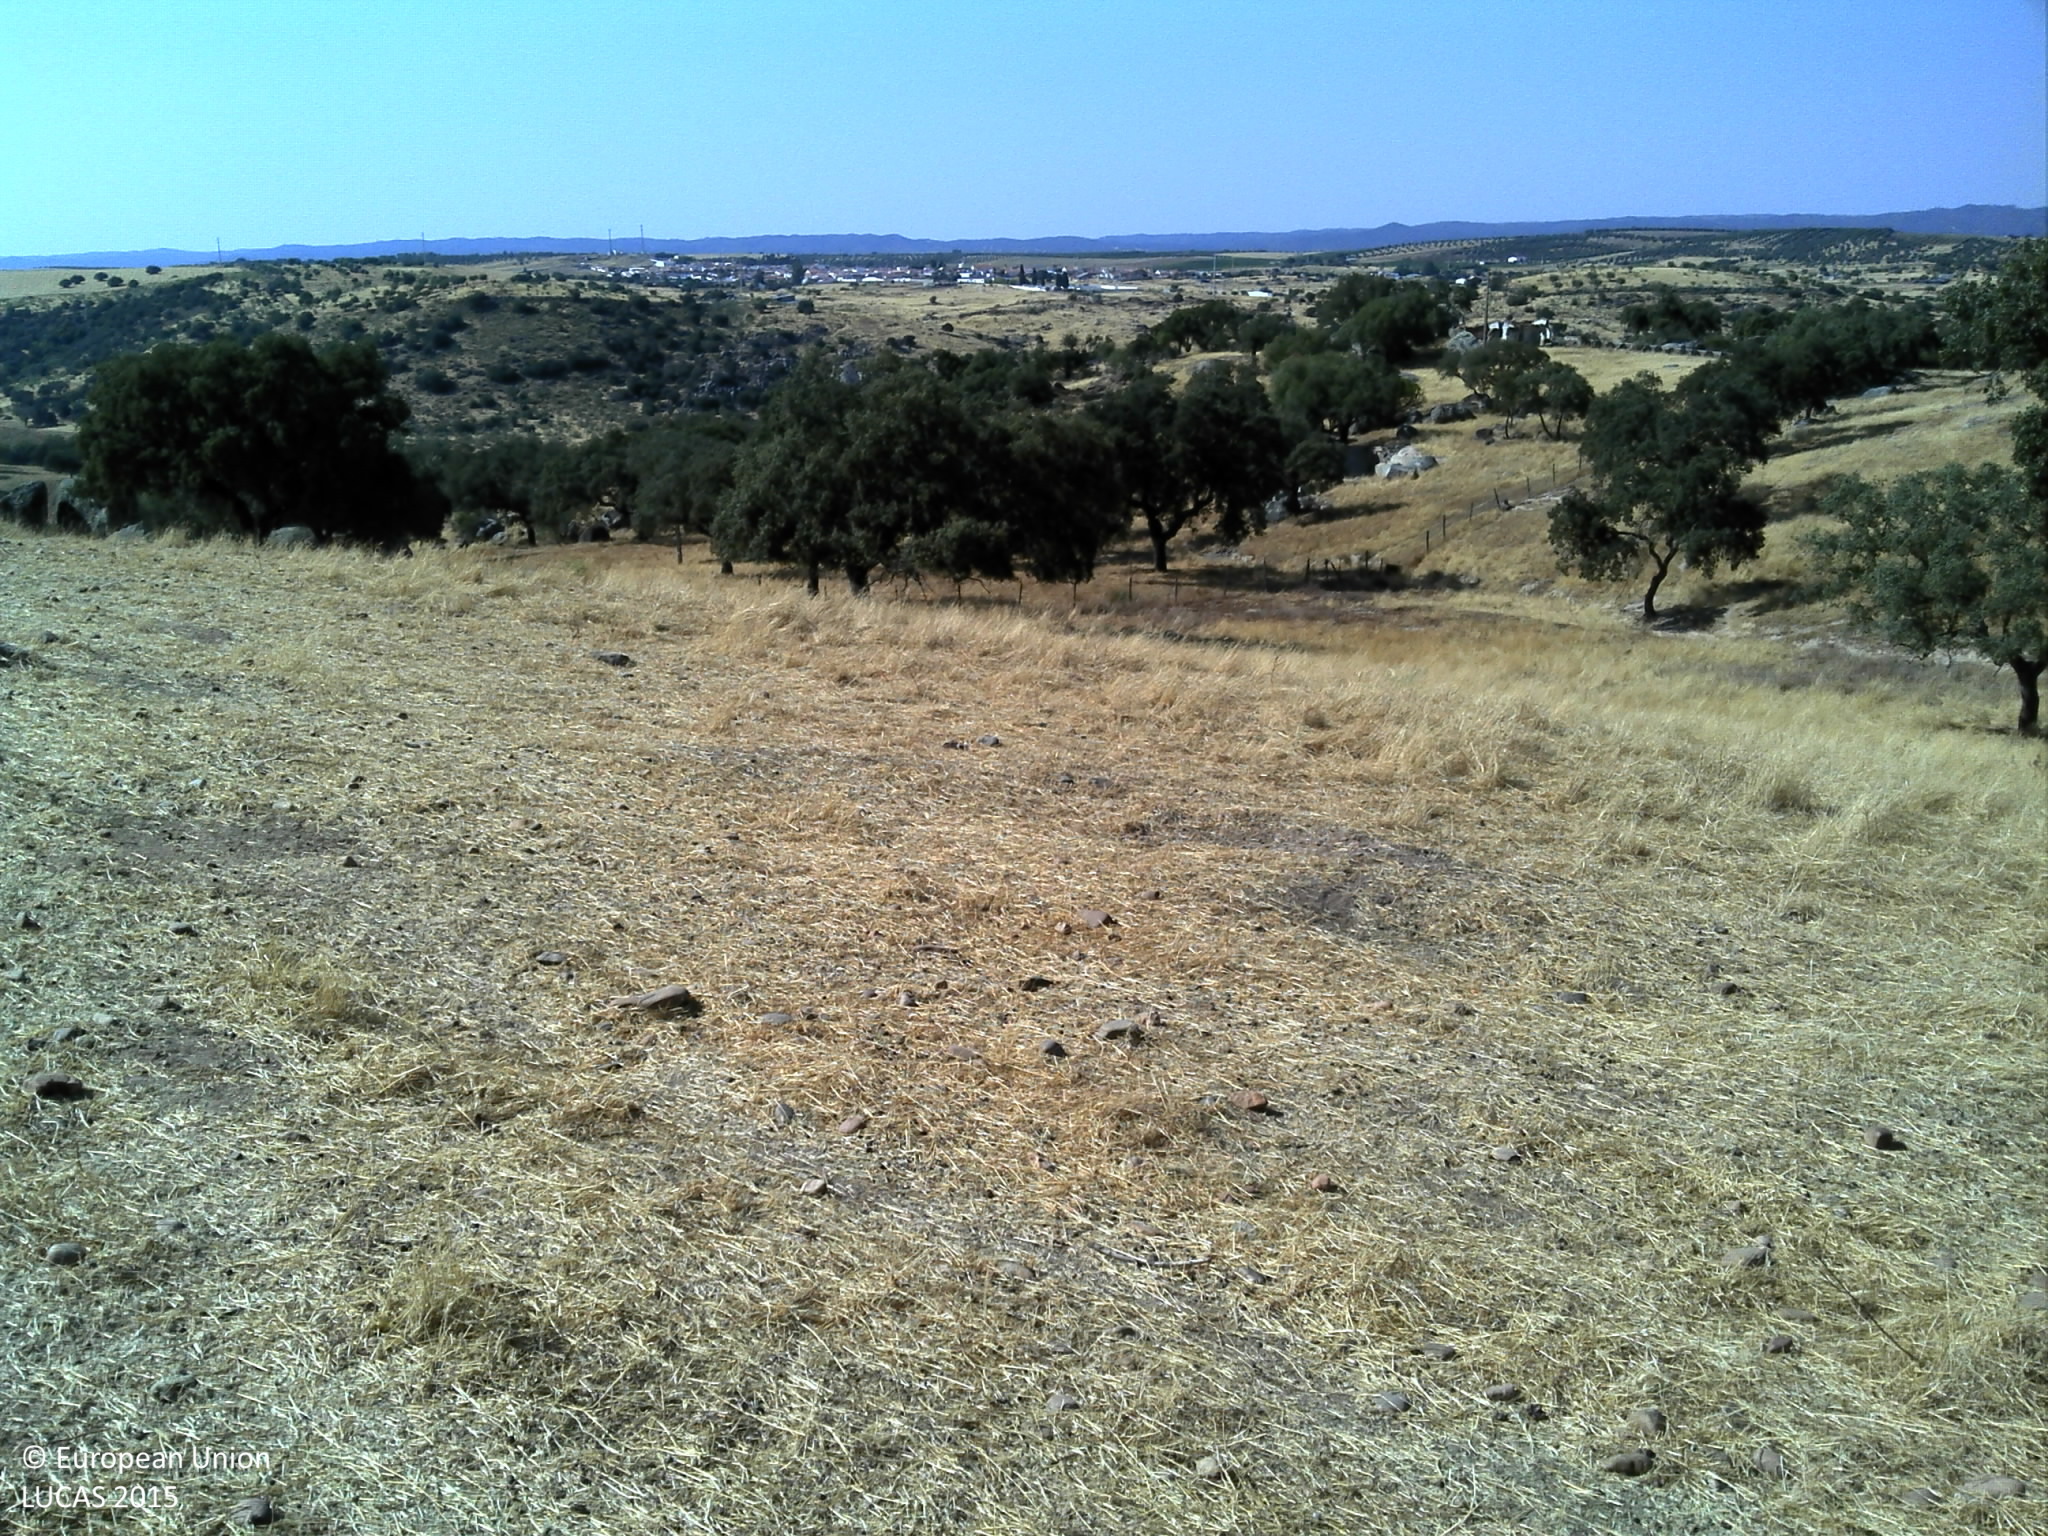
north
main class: Grassland
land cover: Grassland with sparse tree/shrub cover
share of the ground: 25 - 50 %
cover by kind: herbaceous plants 50 %, unconsolidated bare surface 45 %, broadleaved forest trees 5 %
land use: Agriculture (excluding fallow land and kitchen gardens)
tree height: < 5 m
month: June
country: PT
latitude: 38.0999
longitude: -7.6426
